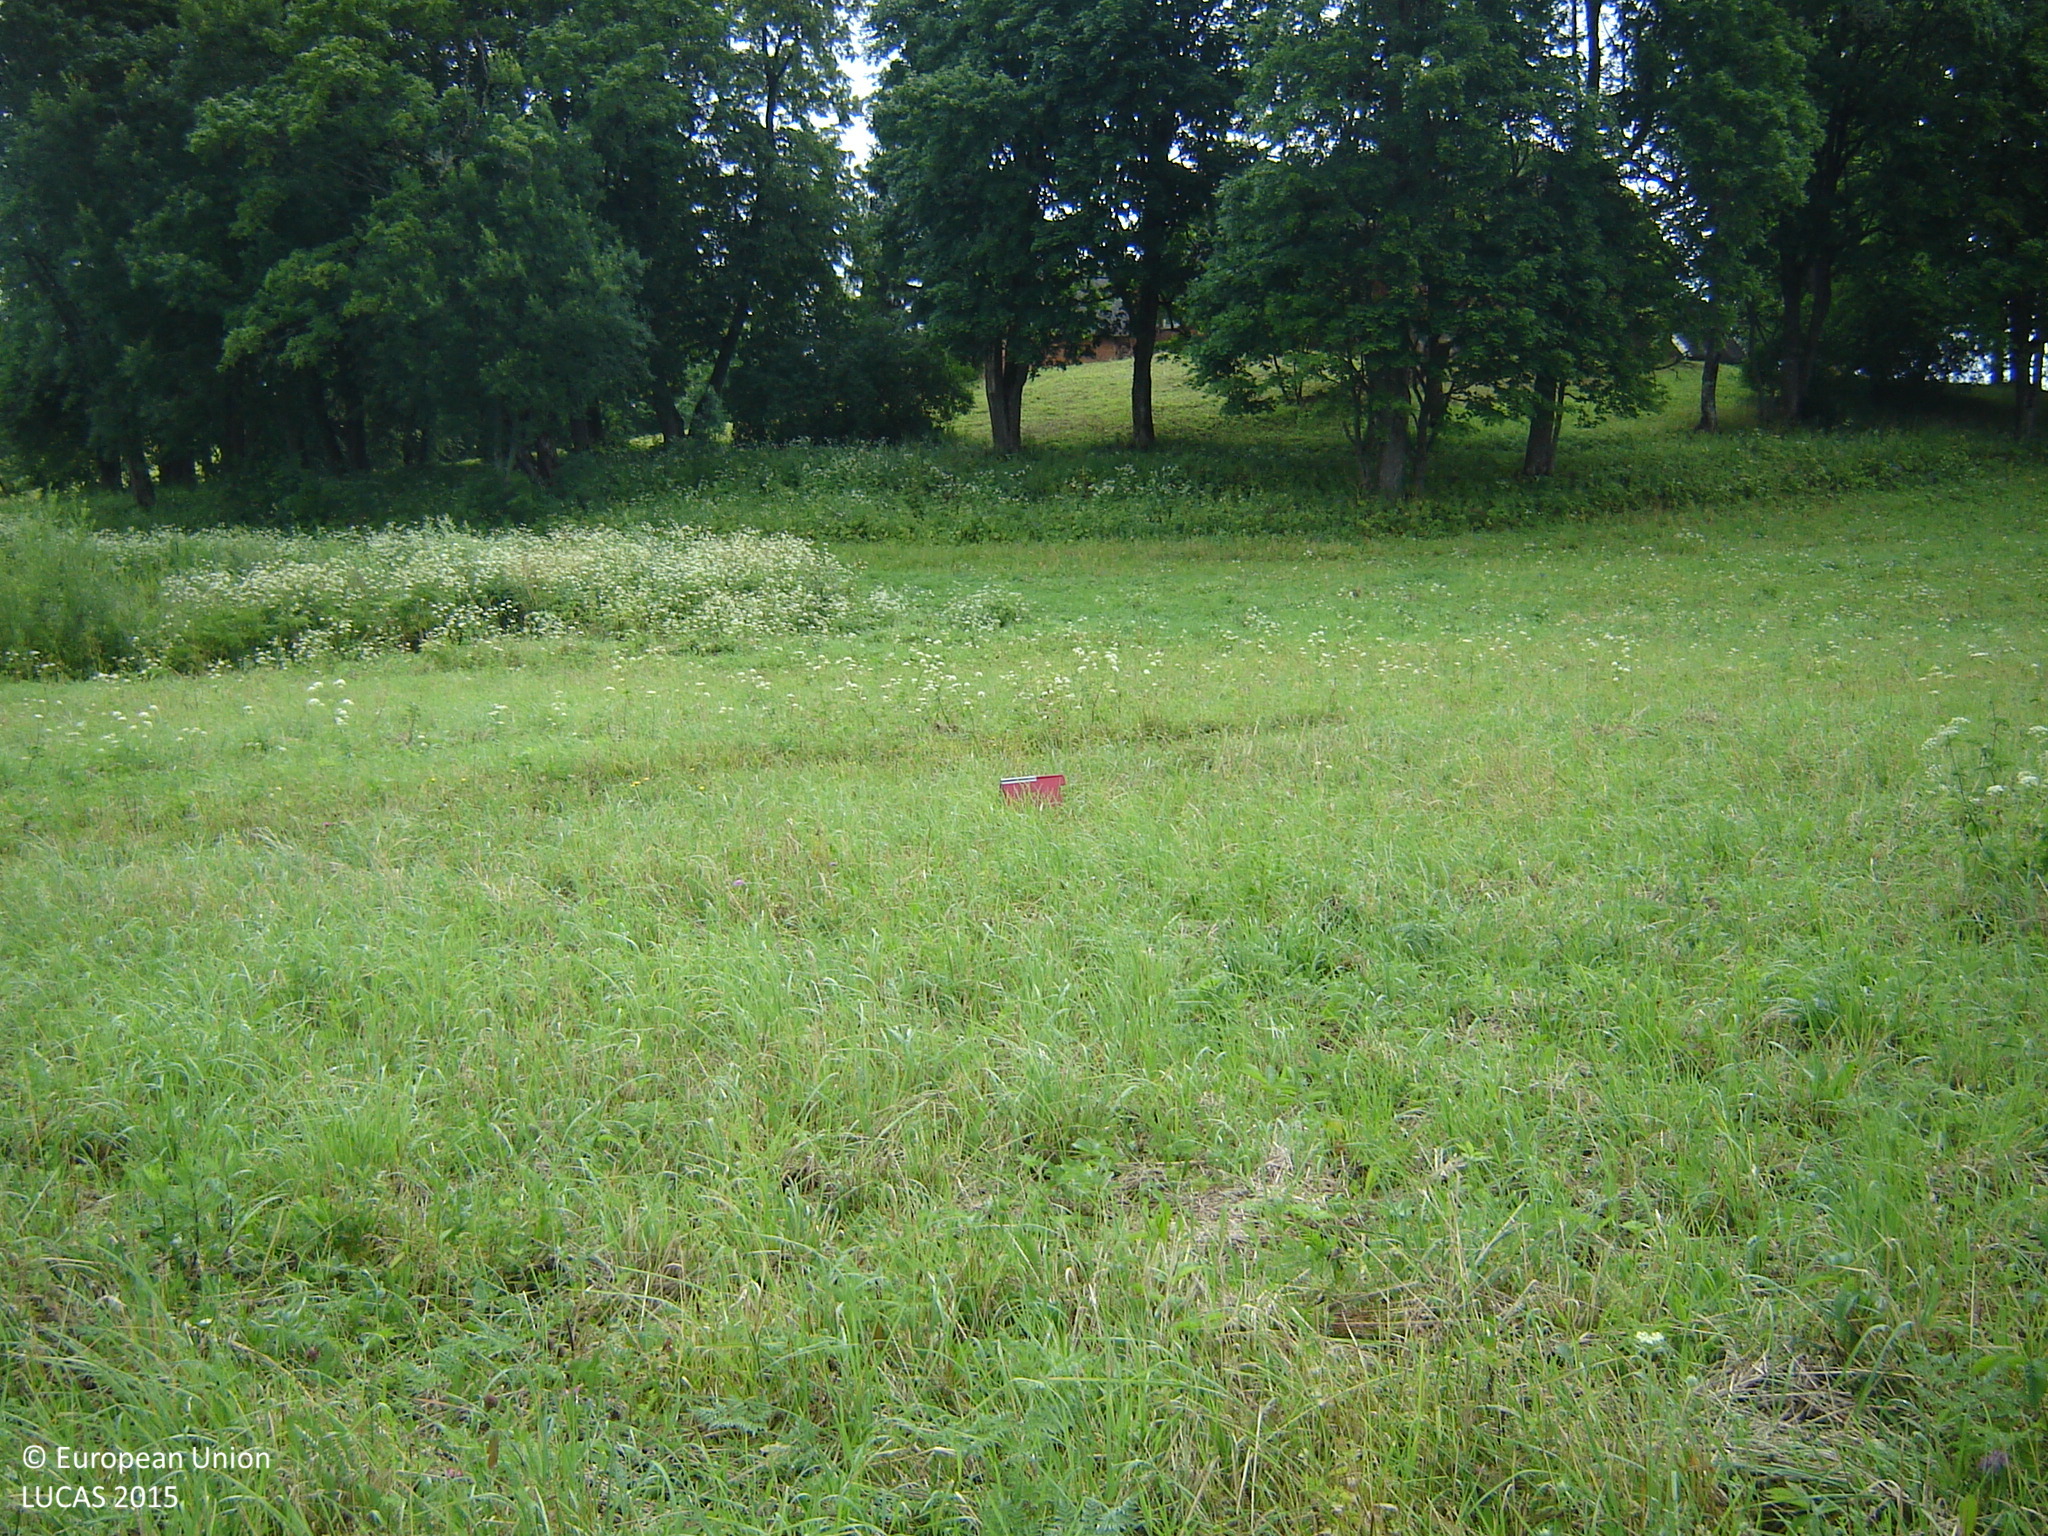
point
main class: Grassland
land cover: Grassland without tree/shrub cover
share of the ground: > 75 %
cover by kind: herbaceous plants 100 %
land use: Agriculture (excluding fallow land and kitchen gardens)
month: July
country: LT
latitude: 55.3992
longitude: 25.2292
